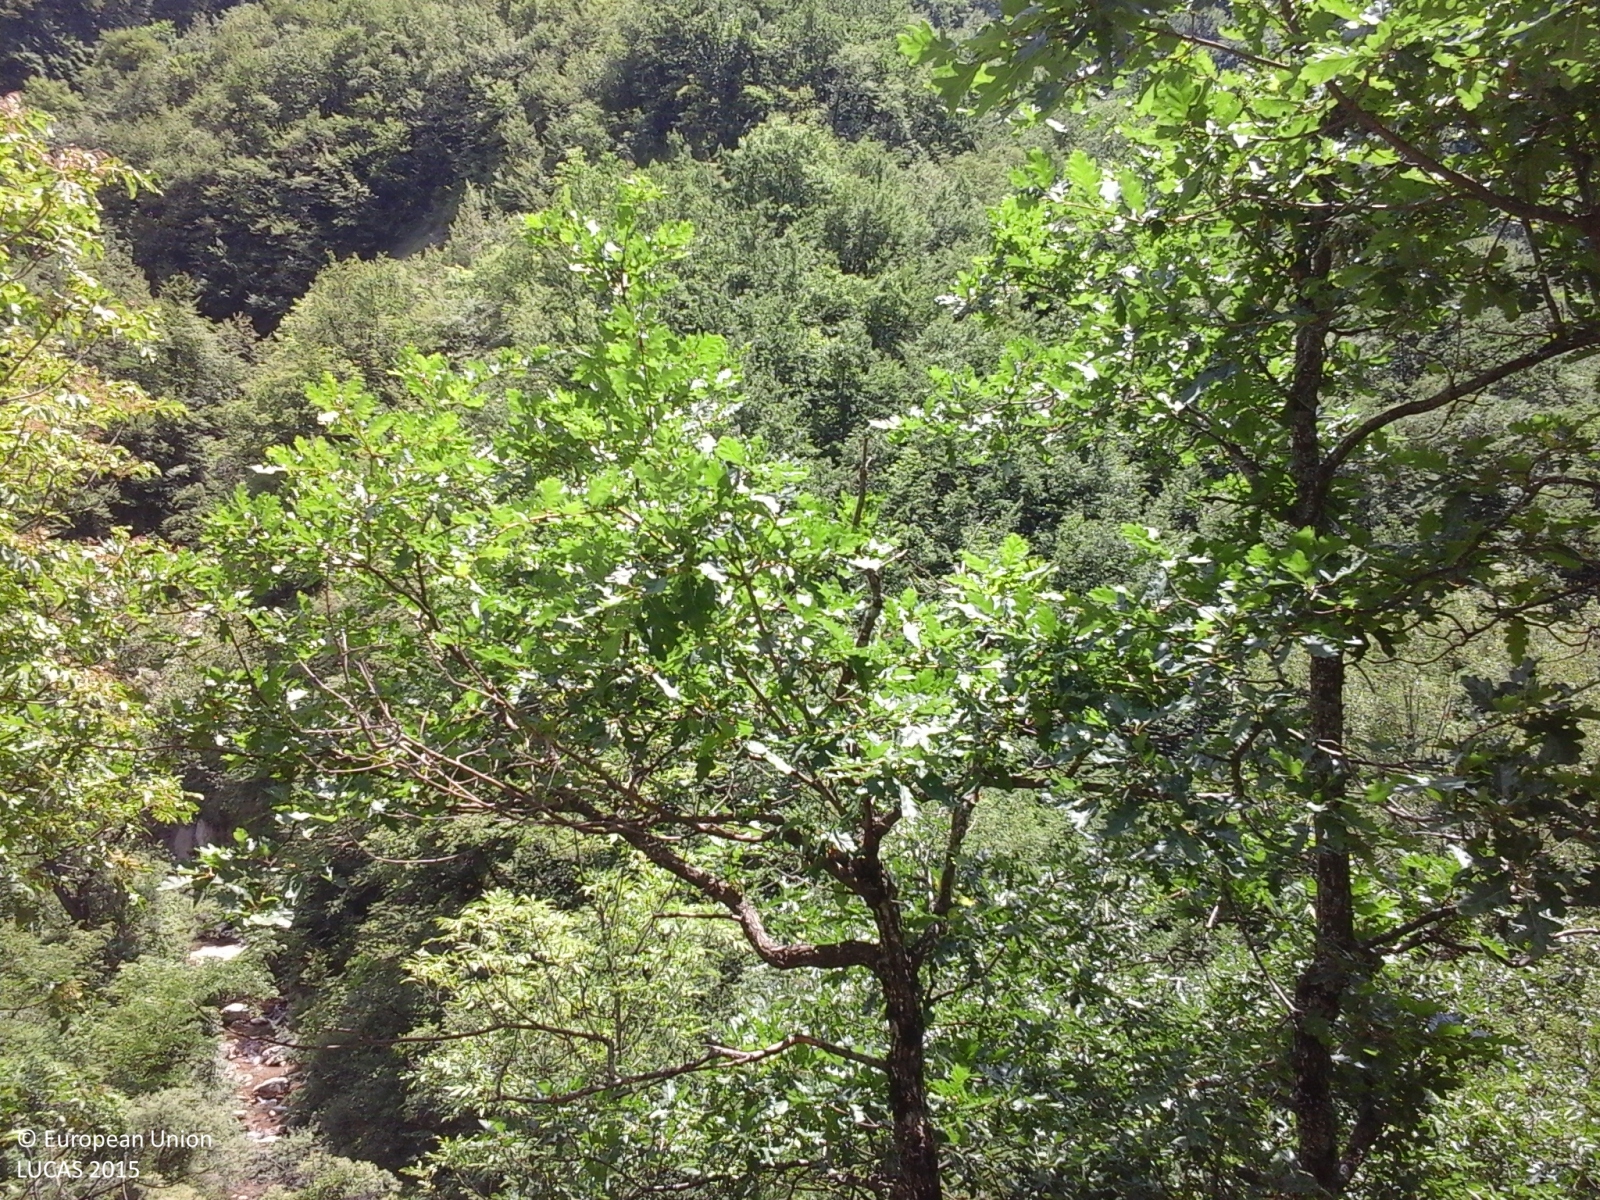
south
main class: Woodland
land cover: Broadleaved woodland
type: thermophilous deciduous forest
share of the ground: > 75 %
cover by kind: broadleaved forest trees 90 %, shrubs 5 %, herbaceous plants 5 %
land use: Forestry
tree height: > 5 m
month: June
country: IT
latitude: 44.6357
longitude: 9.1572
